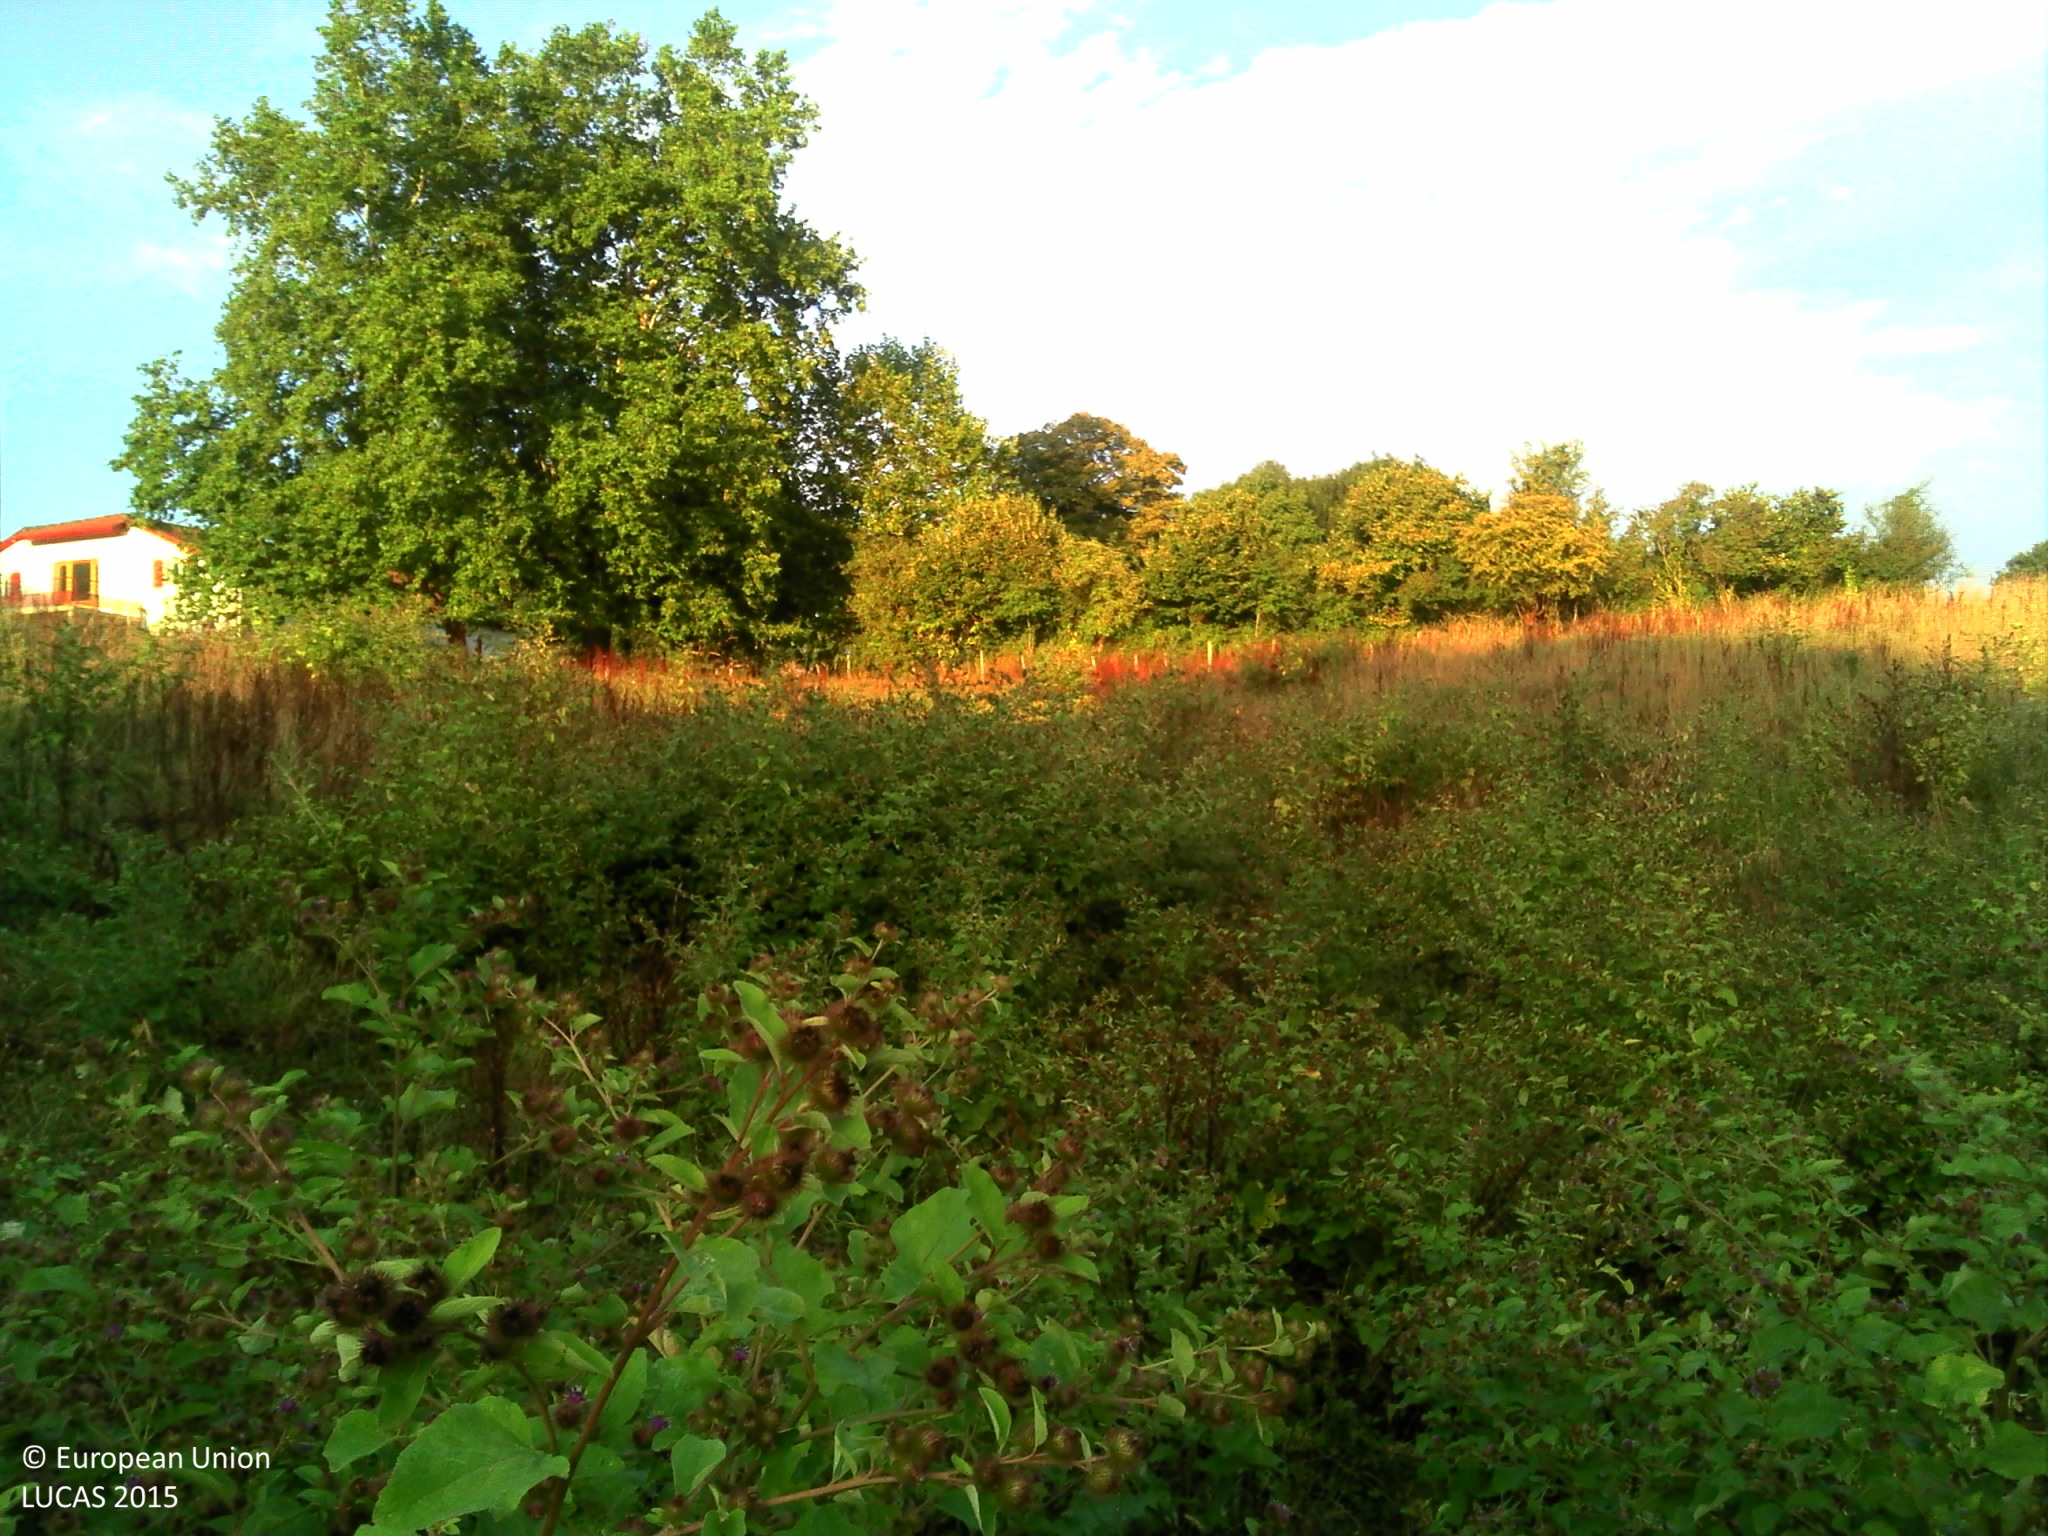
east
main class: Grassland
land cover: Spontaneously vegetated surfaces
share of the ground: > 75 %
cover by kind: herbaceous plants 95 %, shrubs 5 %
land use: Agriculture (excluding fallow land and kitchen gardens)
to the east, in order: Spontaneously vegetated surfaces; Fences; Broadleaved woodland; Grassland without tree/shrub cover; Single bushes/trees; Grassland without tree/shrub cover; Fences; Abandoned hedges; Spontaneously vegetated surfaces; Tracks; Abandoned hedges; Fences; Grassland without tree/shrub cover; Fences; Broadleaved woodland; Maize; Grass margins; Broadleaved woodland
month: August
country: FR
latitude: 43.2908
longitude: -1.1678
